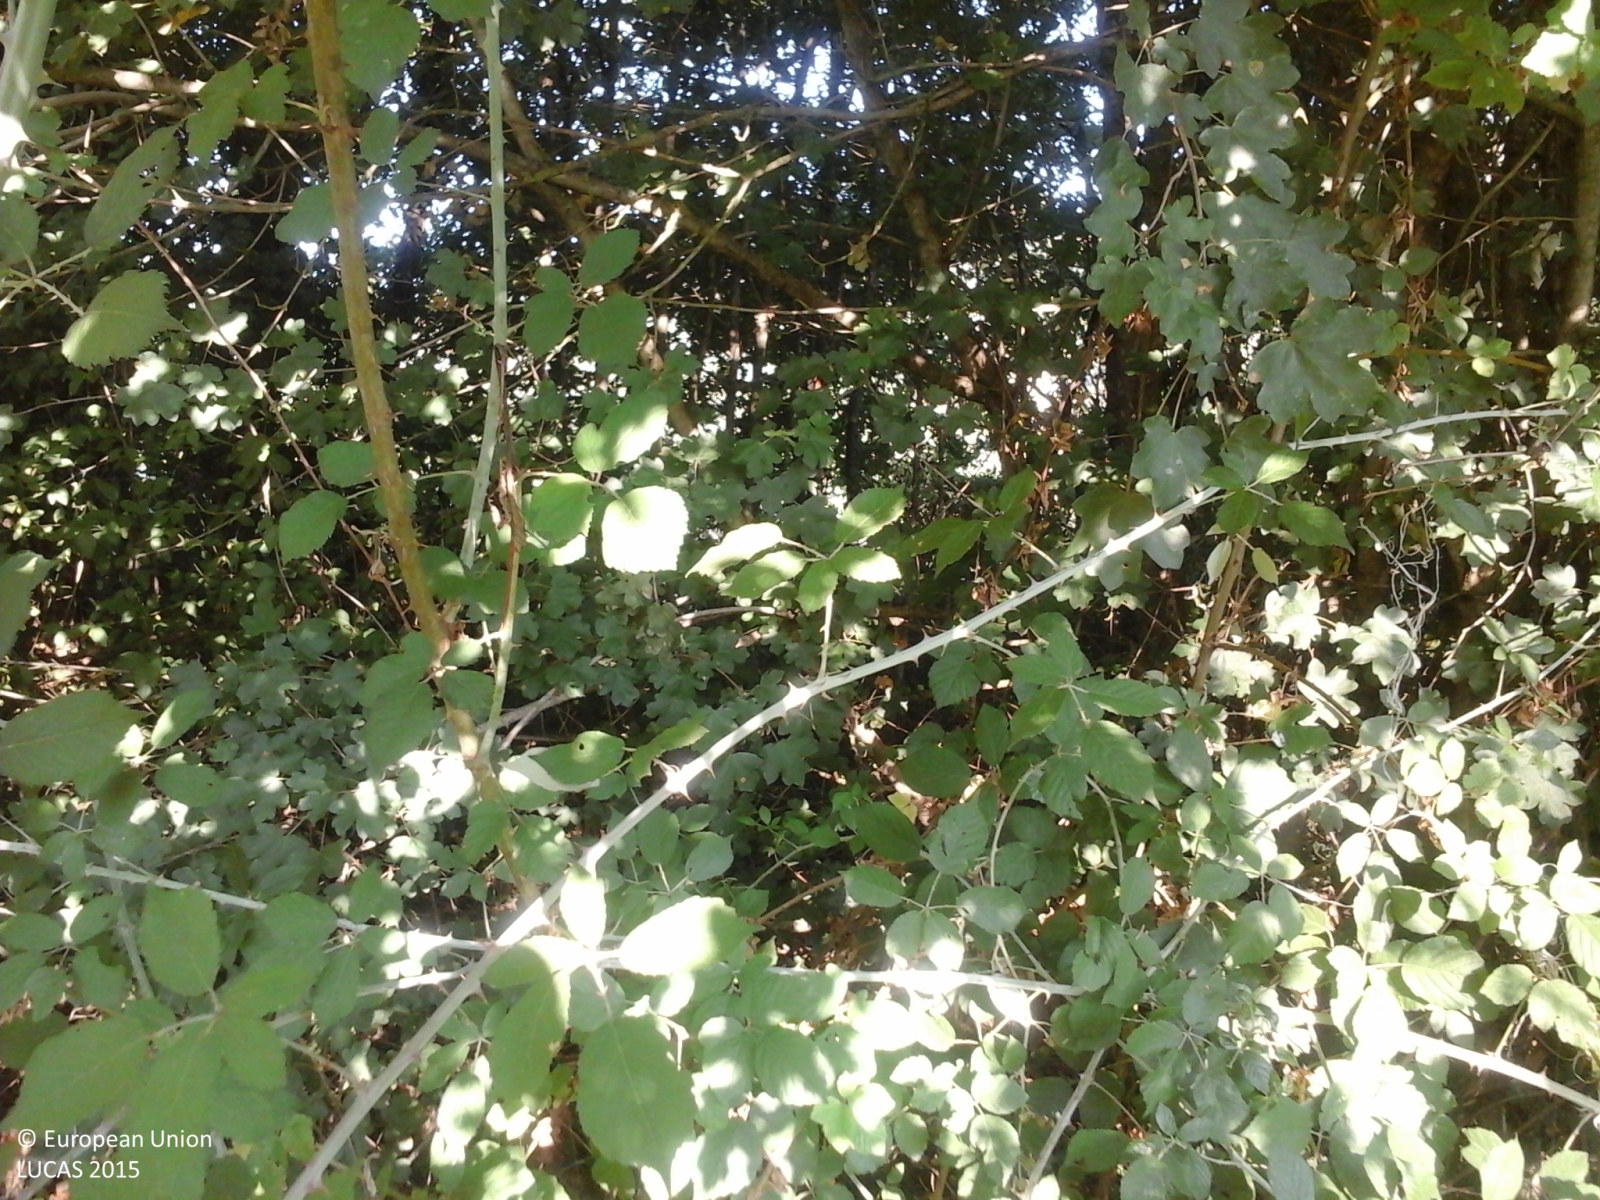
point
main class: Woodland
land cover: Broadleaved woodland
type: thermophilous deciduous forest
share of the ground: > 75 %
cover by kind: broadleaved forest trees 100 %
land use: Semi-natural and natural areas not in use
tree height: > 5 m
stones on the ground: < 10 %
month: August
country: IT
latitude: 43.6007
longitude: 12.4095
